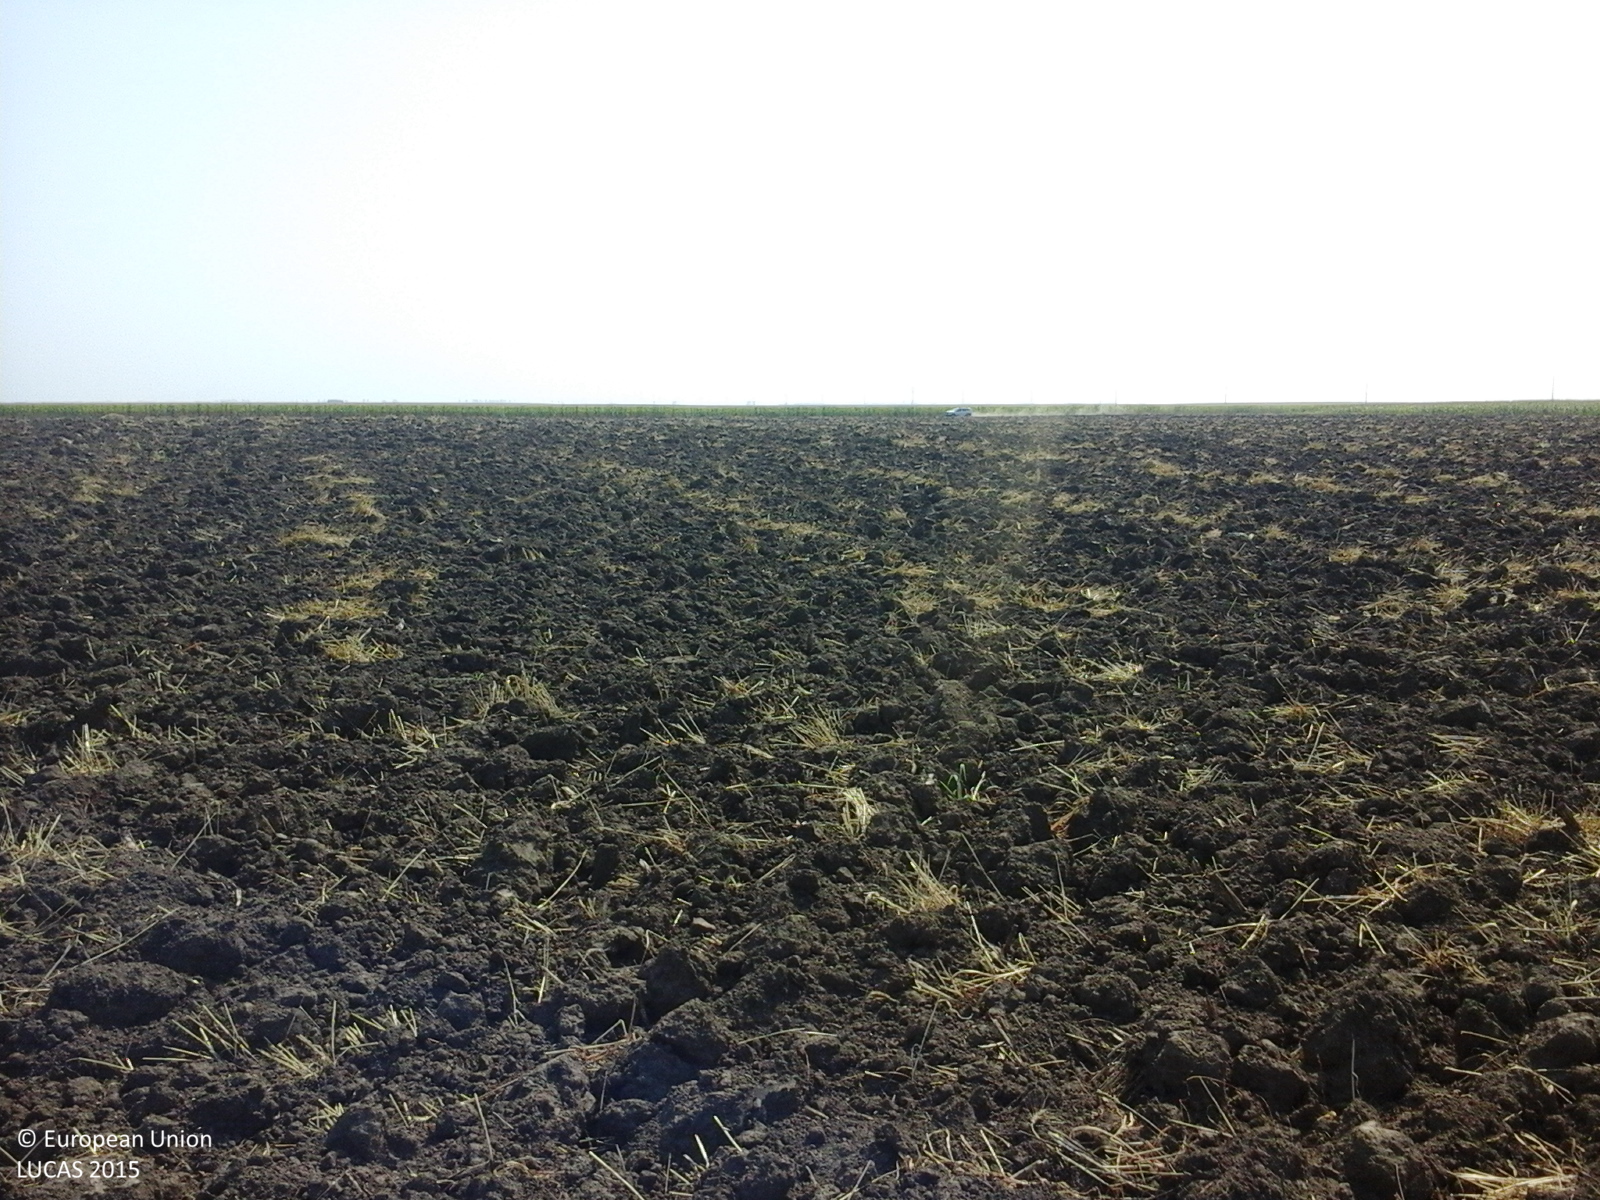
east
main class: Cropland
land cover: Common wheat
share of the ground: < 10 %
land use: Agriculture (excluding fallow land and kitchen gardens)
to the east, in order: Common wheat; Tracks; Maize
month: August
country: RO
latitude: 45.0834
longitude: 27.3595
